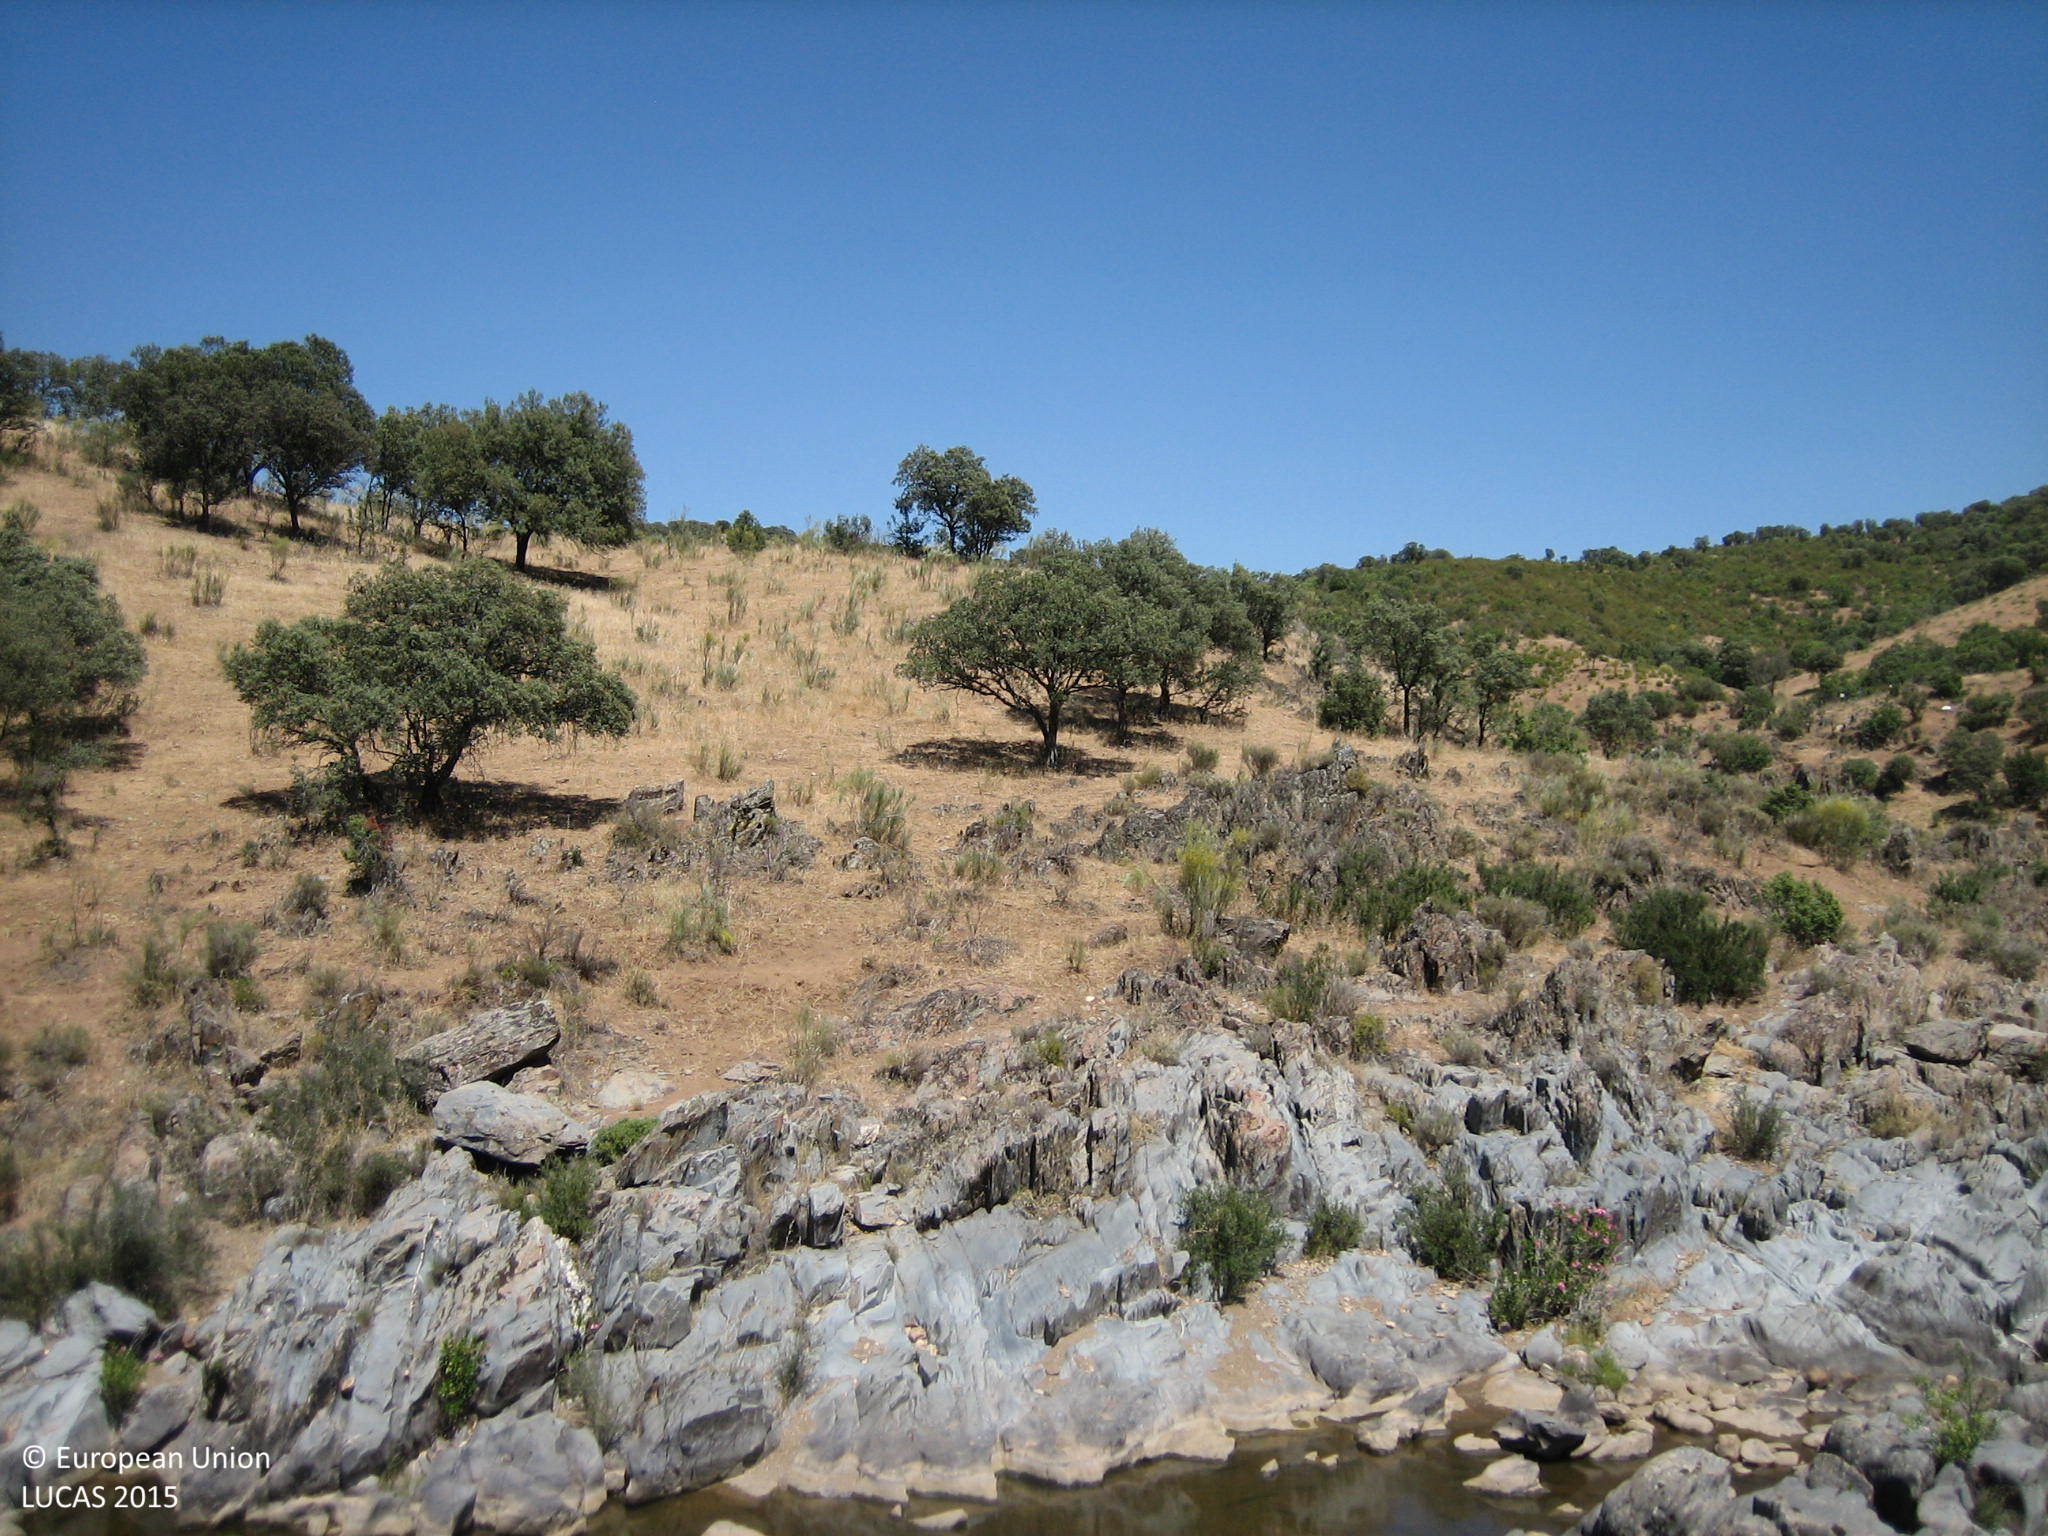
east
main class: Woodland
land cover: Broadleaved woodland
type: broadleaved evergreen forest
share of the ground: > 75 %
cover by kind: shrubs 80 %, broadleaved forest trees 20 %
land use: Forestry
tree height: < 5 m
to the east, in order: Broadleaved woodland; Fences; Grassland with sparse tree/shrub cover; Rocks and stones; Inland fresh running water; Rocks and stones; Grassland with sparse tree/shrub cover
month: May
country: ES
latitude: 38.4569
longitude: -3.9593
